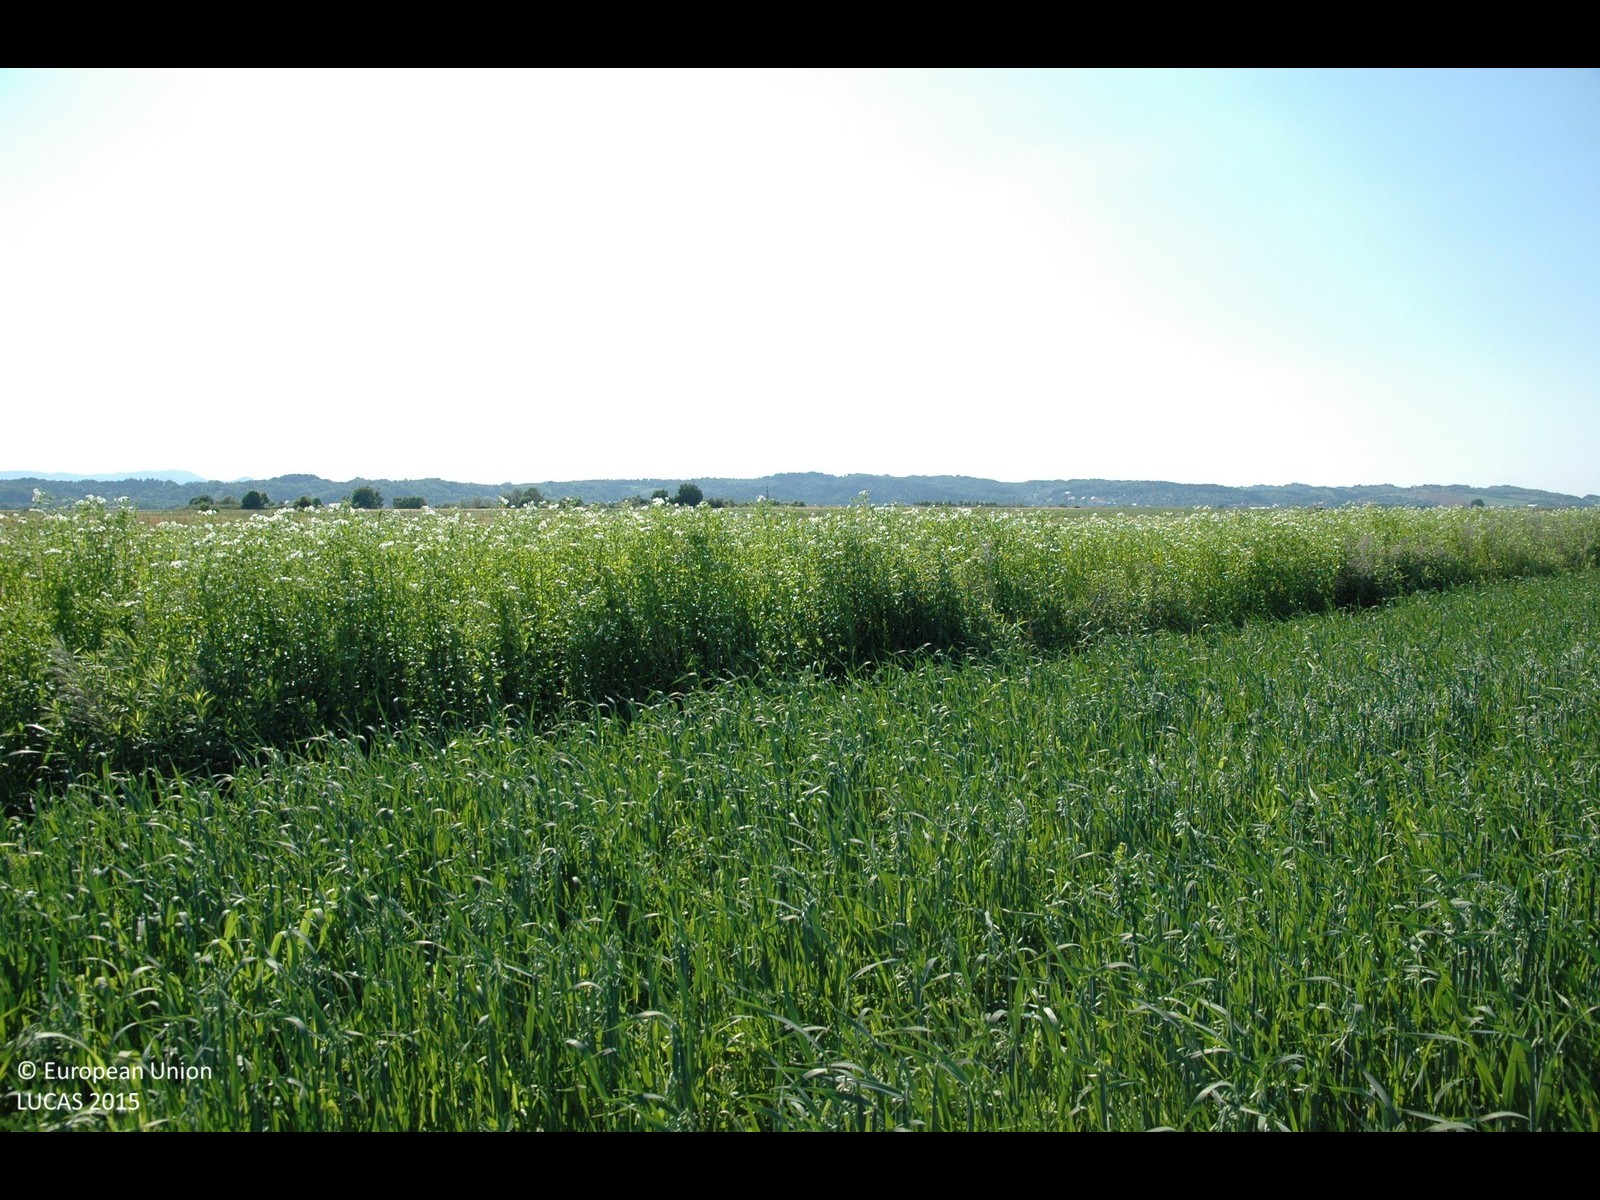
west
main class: Cropland
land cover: Oats
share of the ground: > 75 %
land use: Agriculture (excluding fallow land and kitchen gardens)
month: June
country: HR
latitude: 46.3162
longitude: 16.1944
